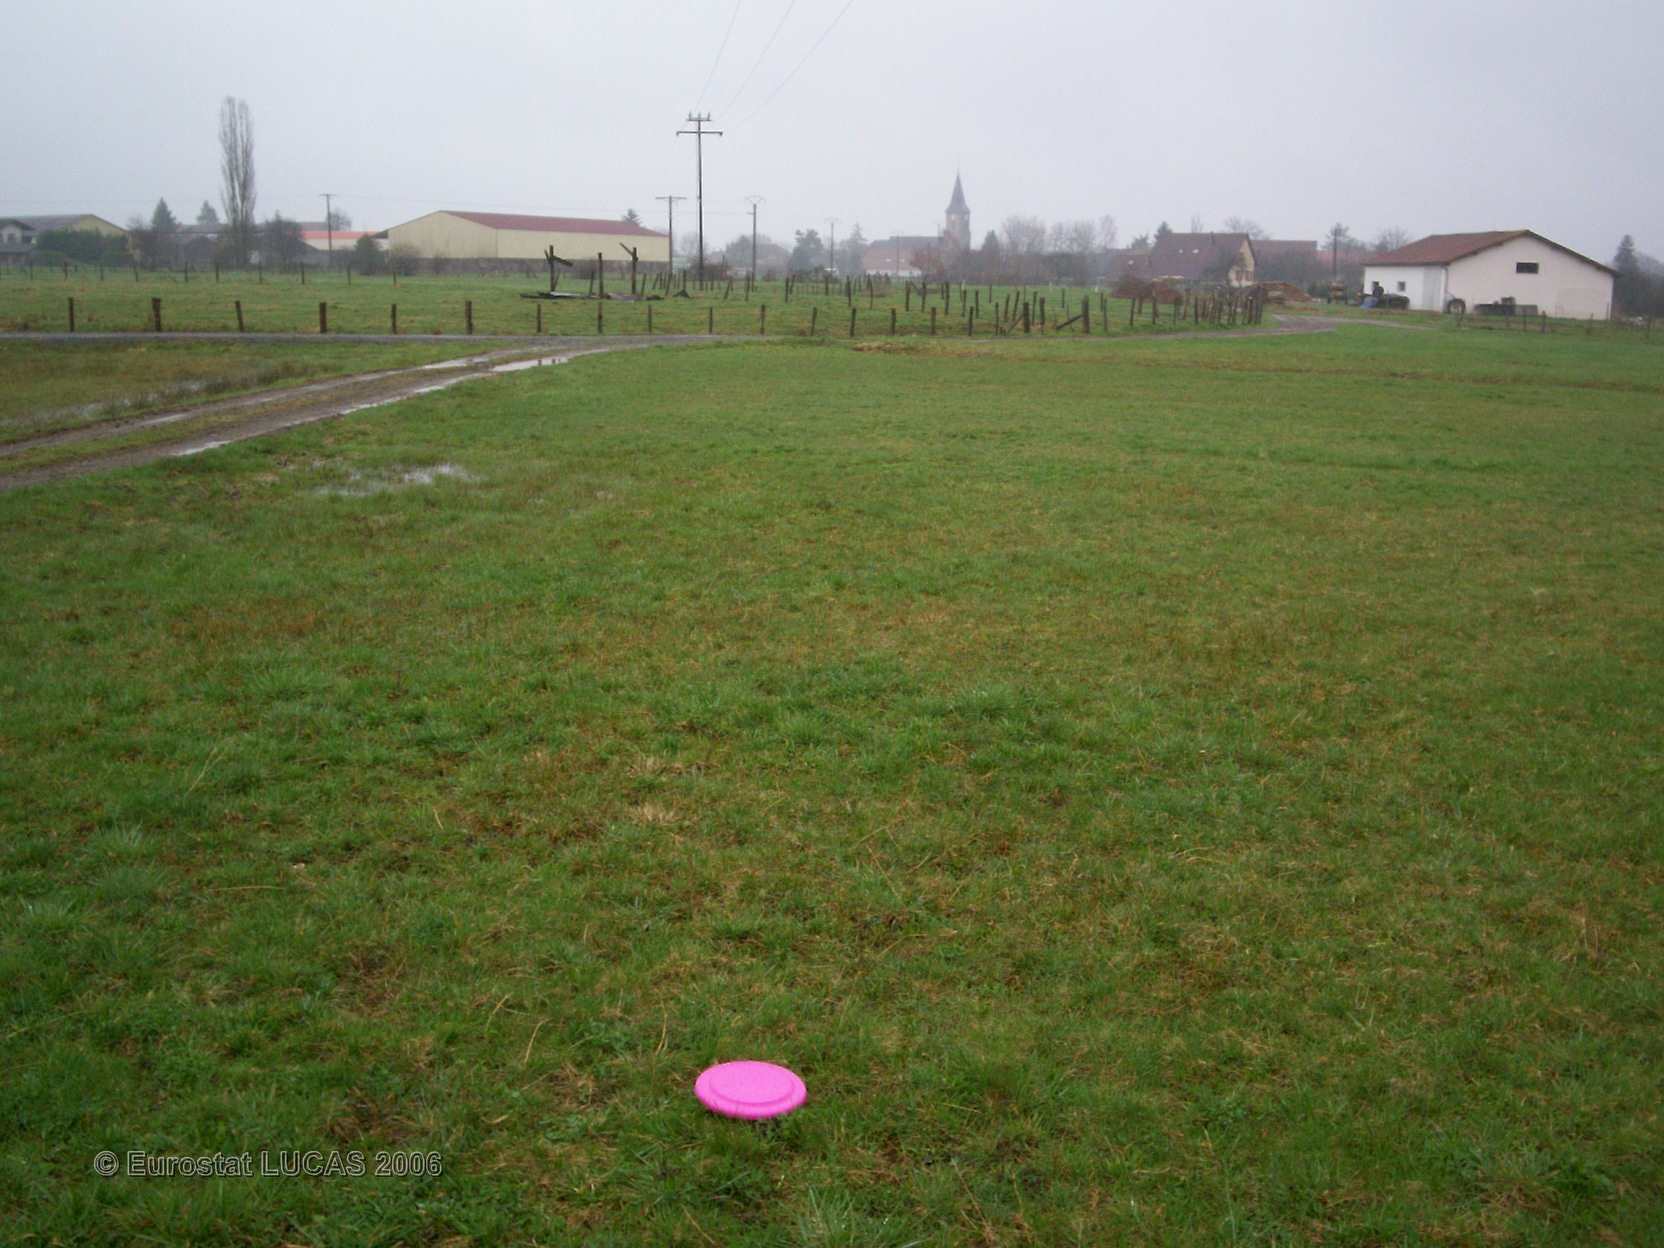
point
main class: Grassland
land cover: Grassland without tree/shrub cover
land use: Agriculture (excluding fallow land and kitchen gardens)
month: April
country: FR
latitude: 47.7093
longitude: 6.8160
